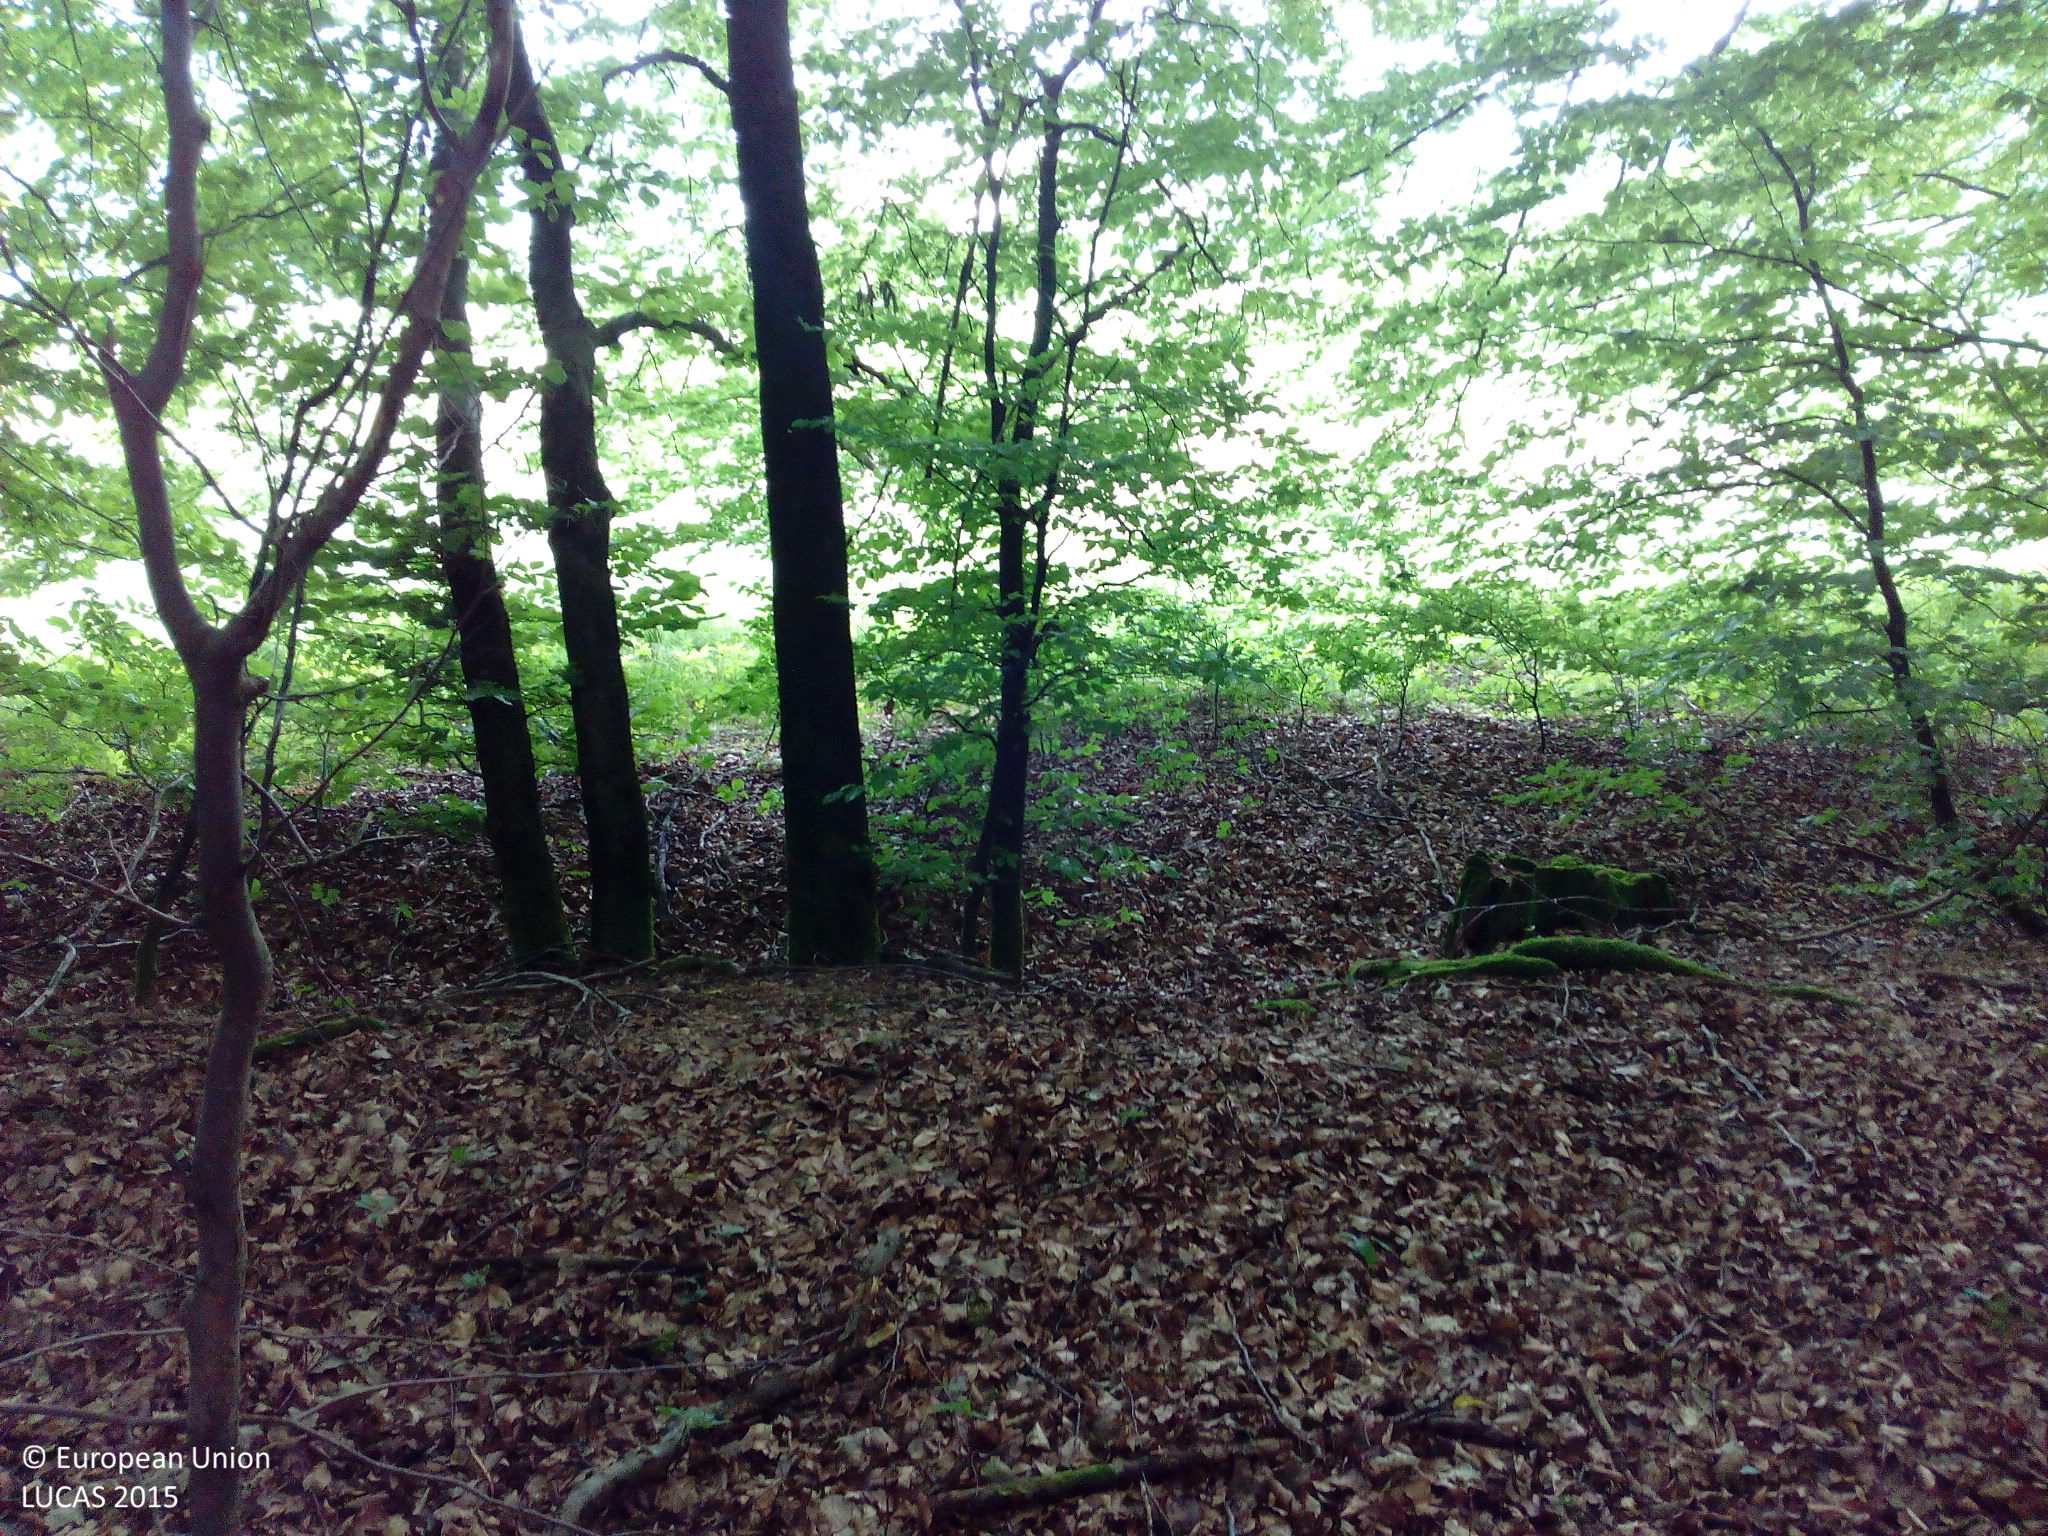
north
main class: Woodland
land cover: Broadleaved woodland
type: mesophytic deciduous forest
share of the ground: > 75 %
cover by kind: broadleaved forest trees 100 %
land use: Forestry
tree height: > 5 m
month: June
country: DE
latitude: 48.7269
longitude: 9.6875
